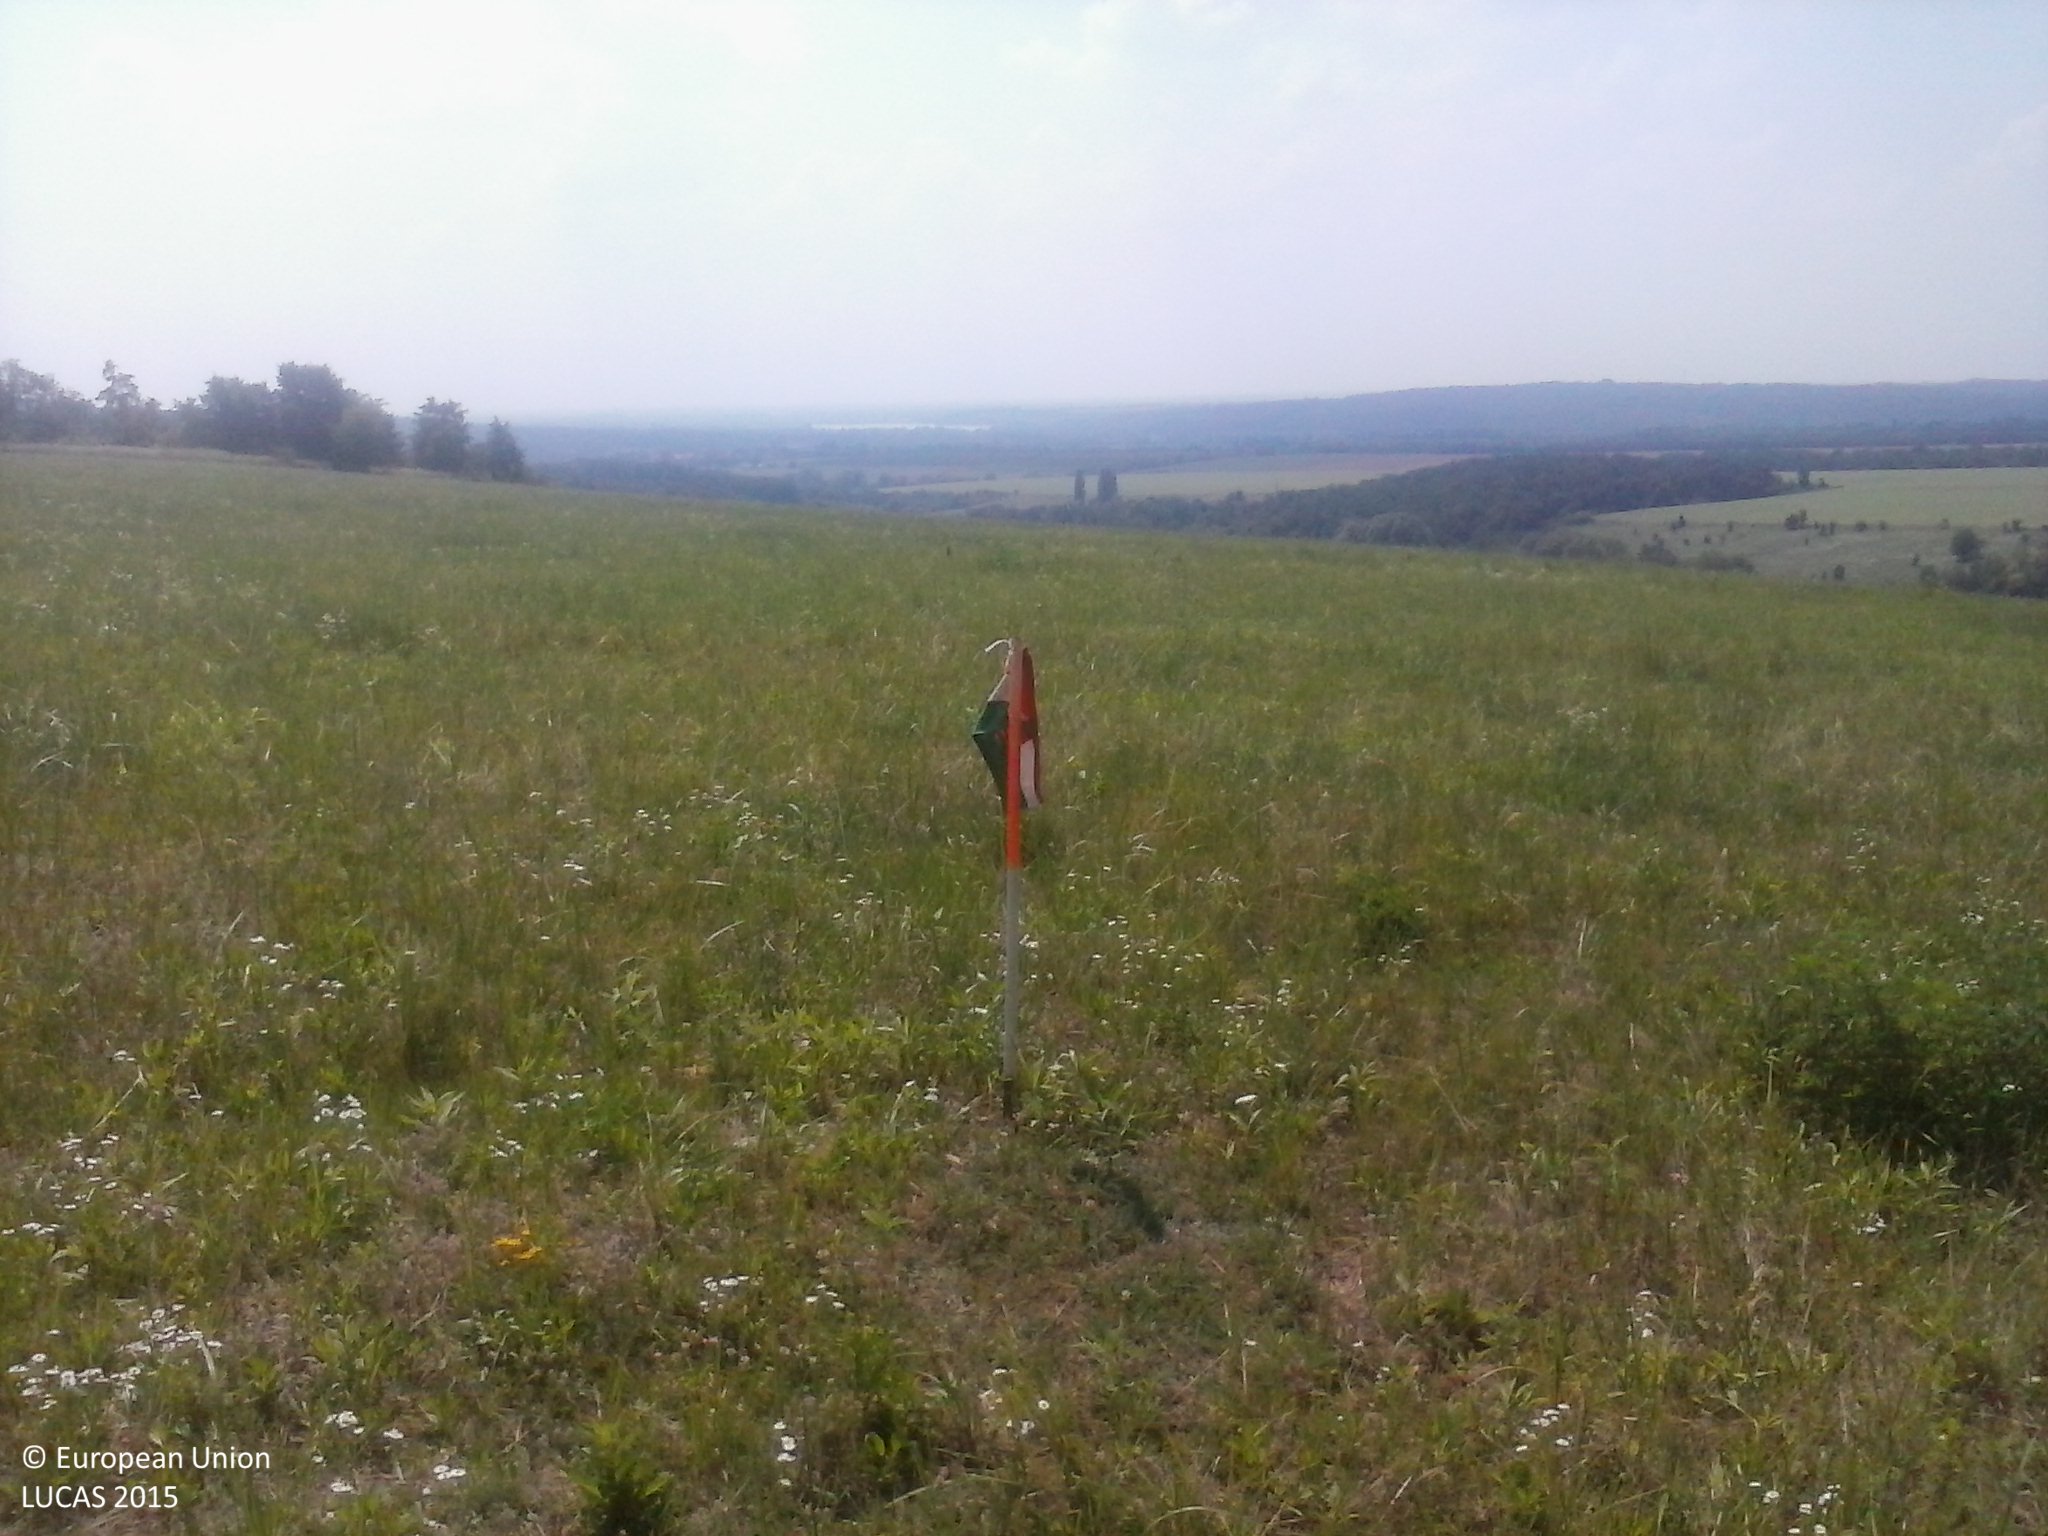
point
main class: Grassland
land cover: Grassland without tree/shrub cover
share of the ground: > 75 %
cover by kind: herbaceous plants 100 %
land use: Agriculture (excluding fallow land and kitchen gardens)
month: August
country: HU
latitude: 46.1339
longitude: 17.8622
